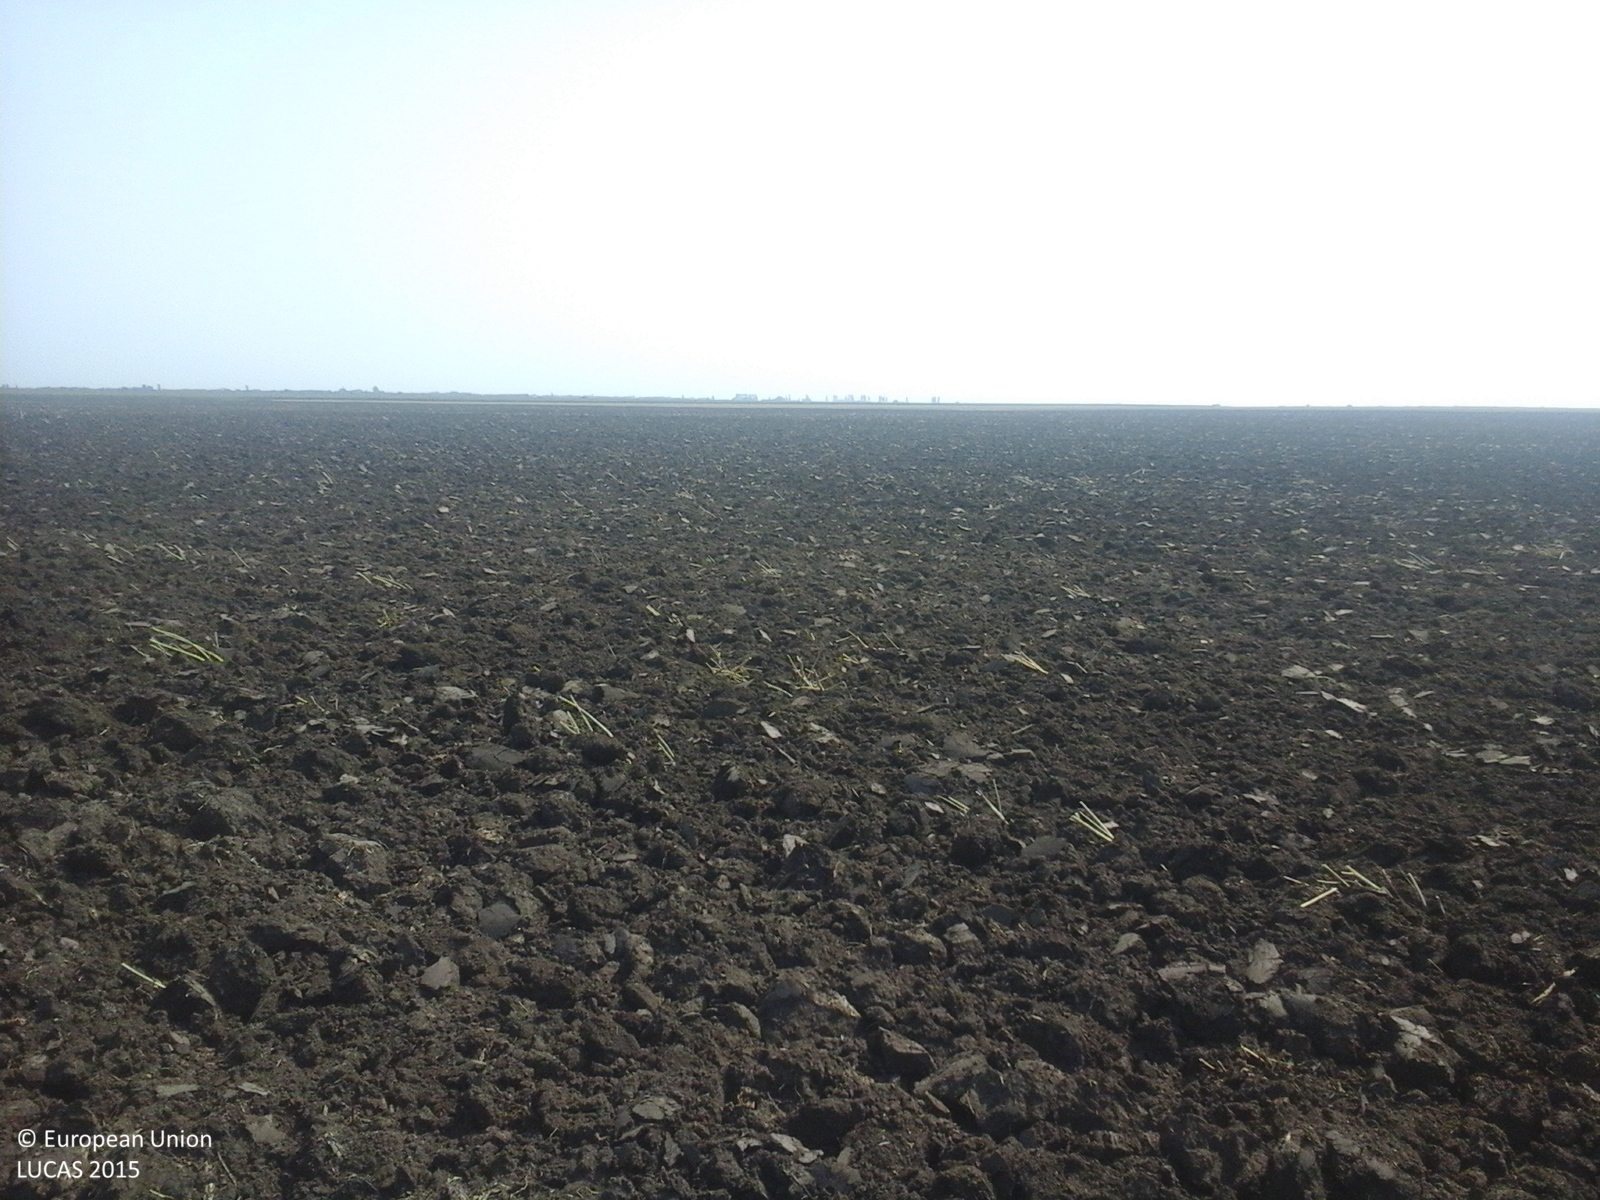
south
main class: Cropland
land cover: Rape and turnip rape
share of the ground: < 10 %
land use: Agriculture (excluding fallow land and kitchen gardens)
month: July
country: RO
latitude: 44.9124
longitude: 26.8360
